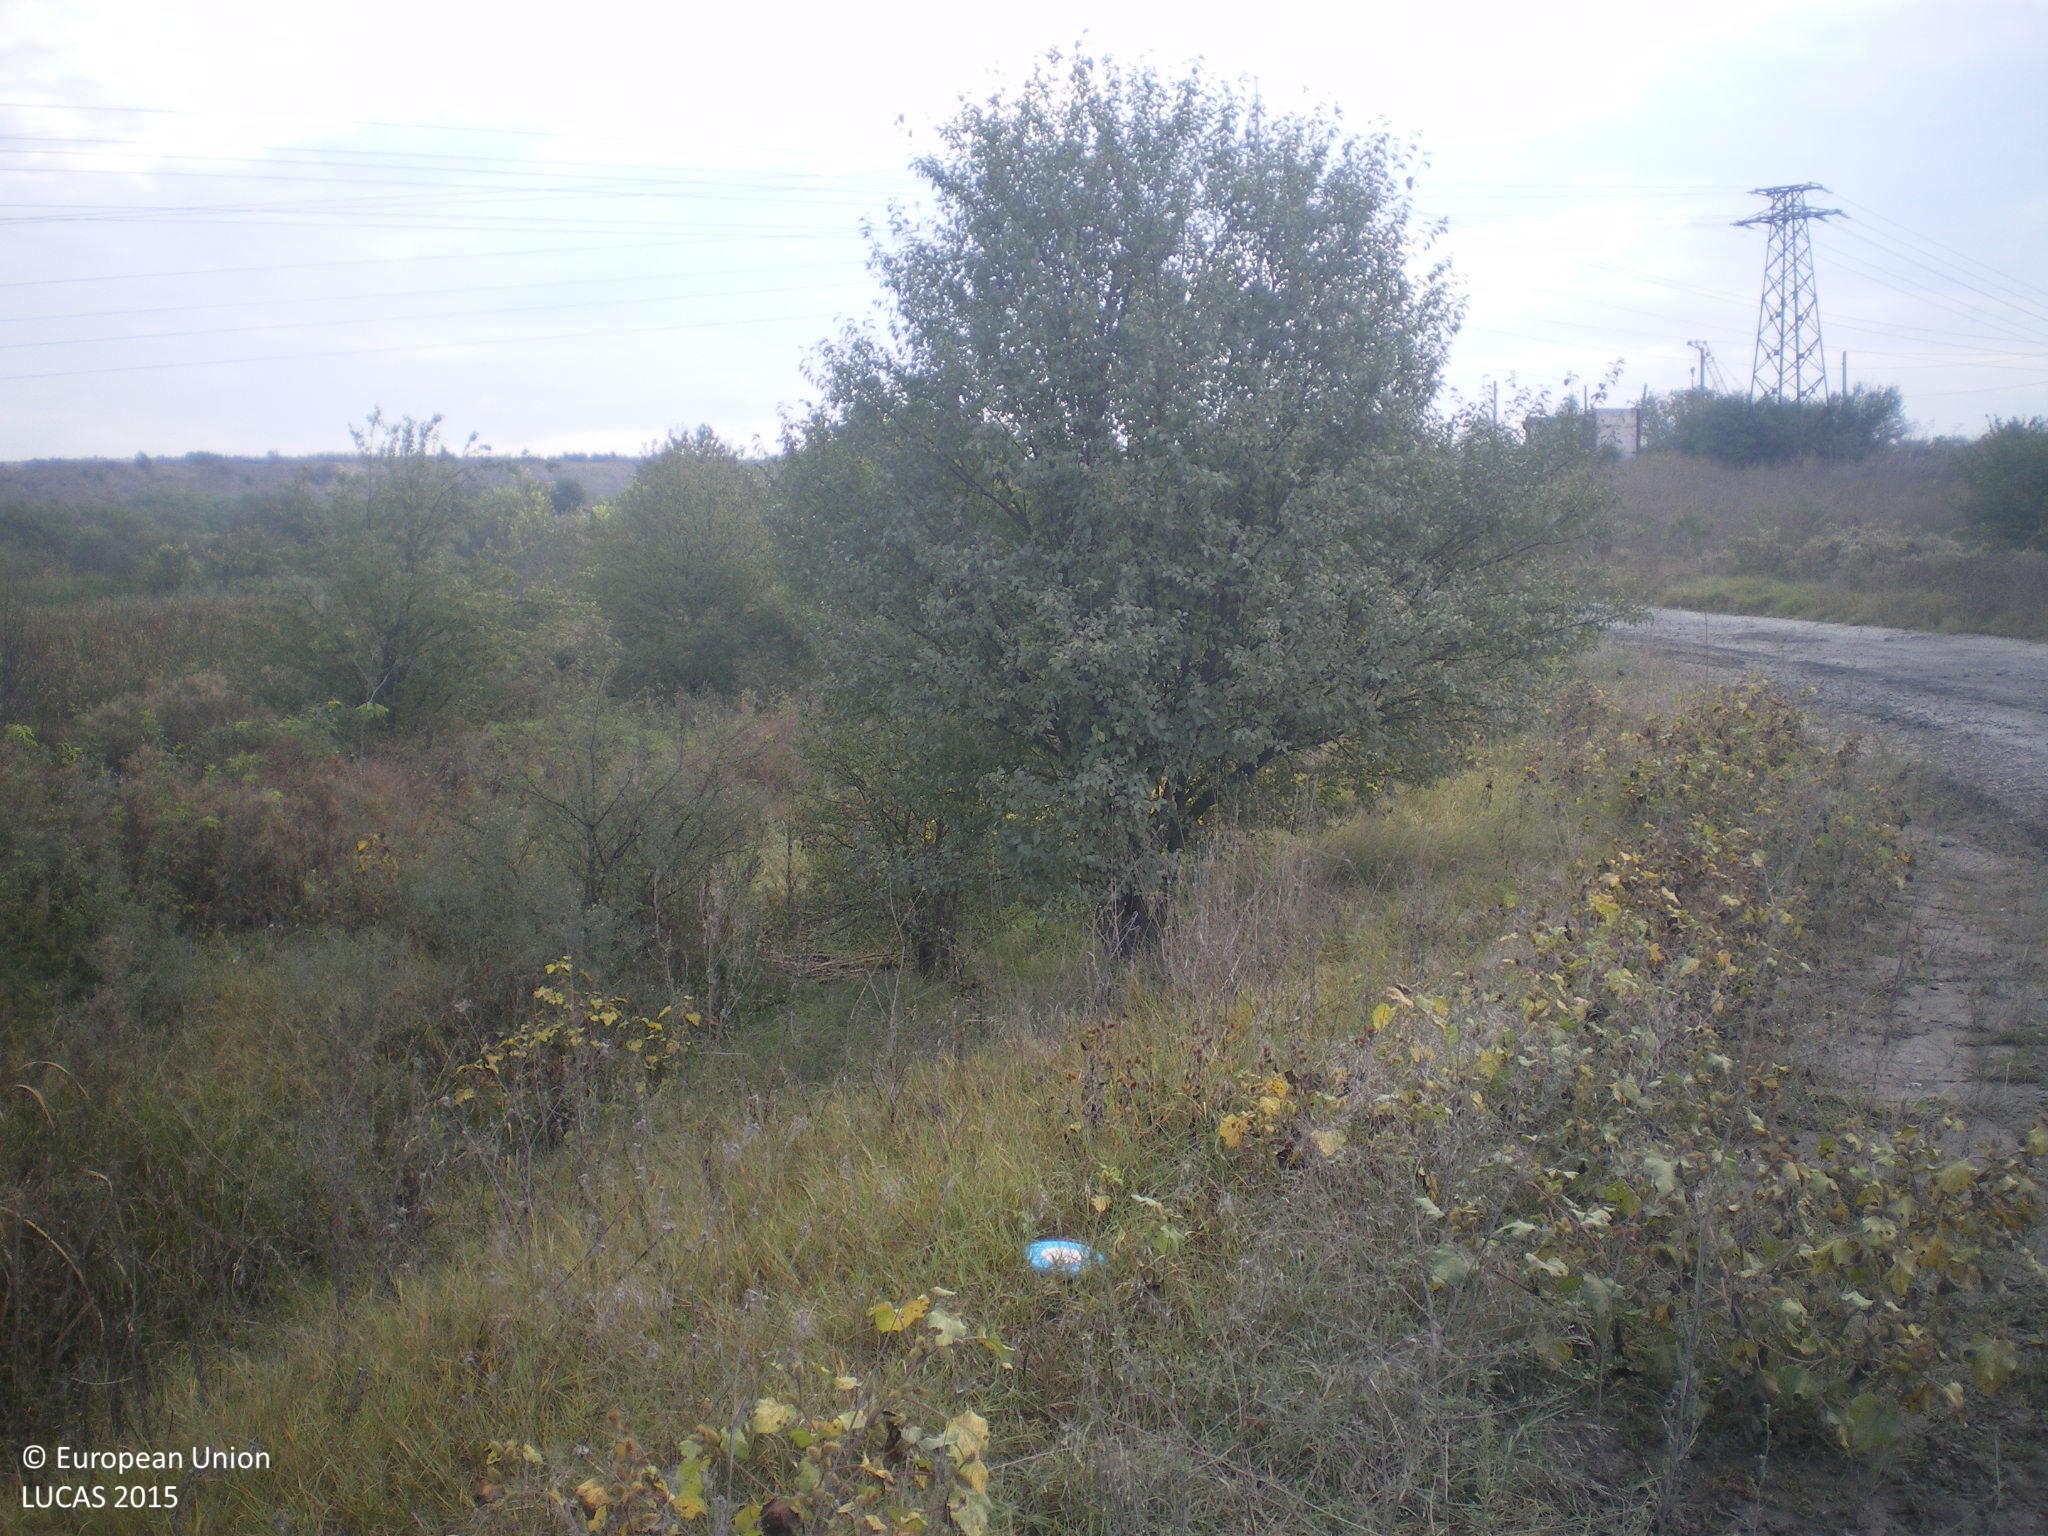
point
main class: Grassland
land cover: Grassland with sparse tree/shrub cover
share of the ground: > 75 %
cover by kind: herbaceous plants 90 %, broadleaved forest trees 5 %, shrubs 5 %
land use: Mining and quarrying
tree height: > 5 m
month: October
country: BG
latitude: 42.2518
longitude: 26.0168
